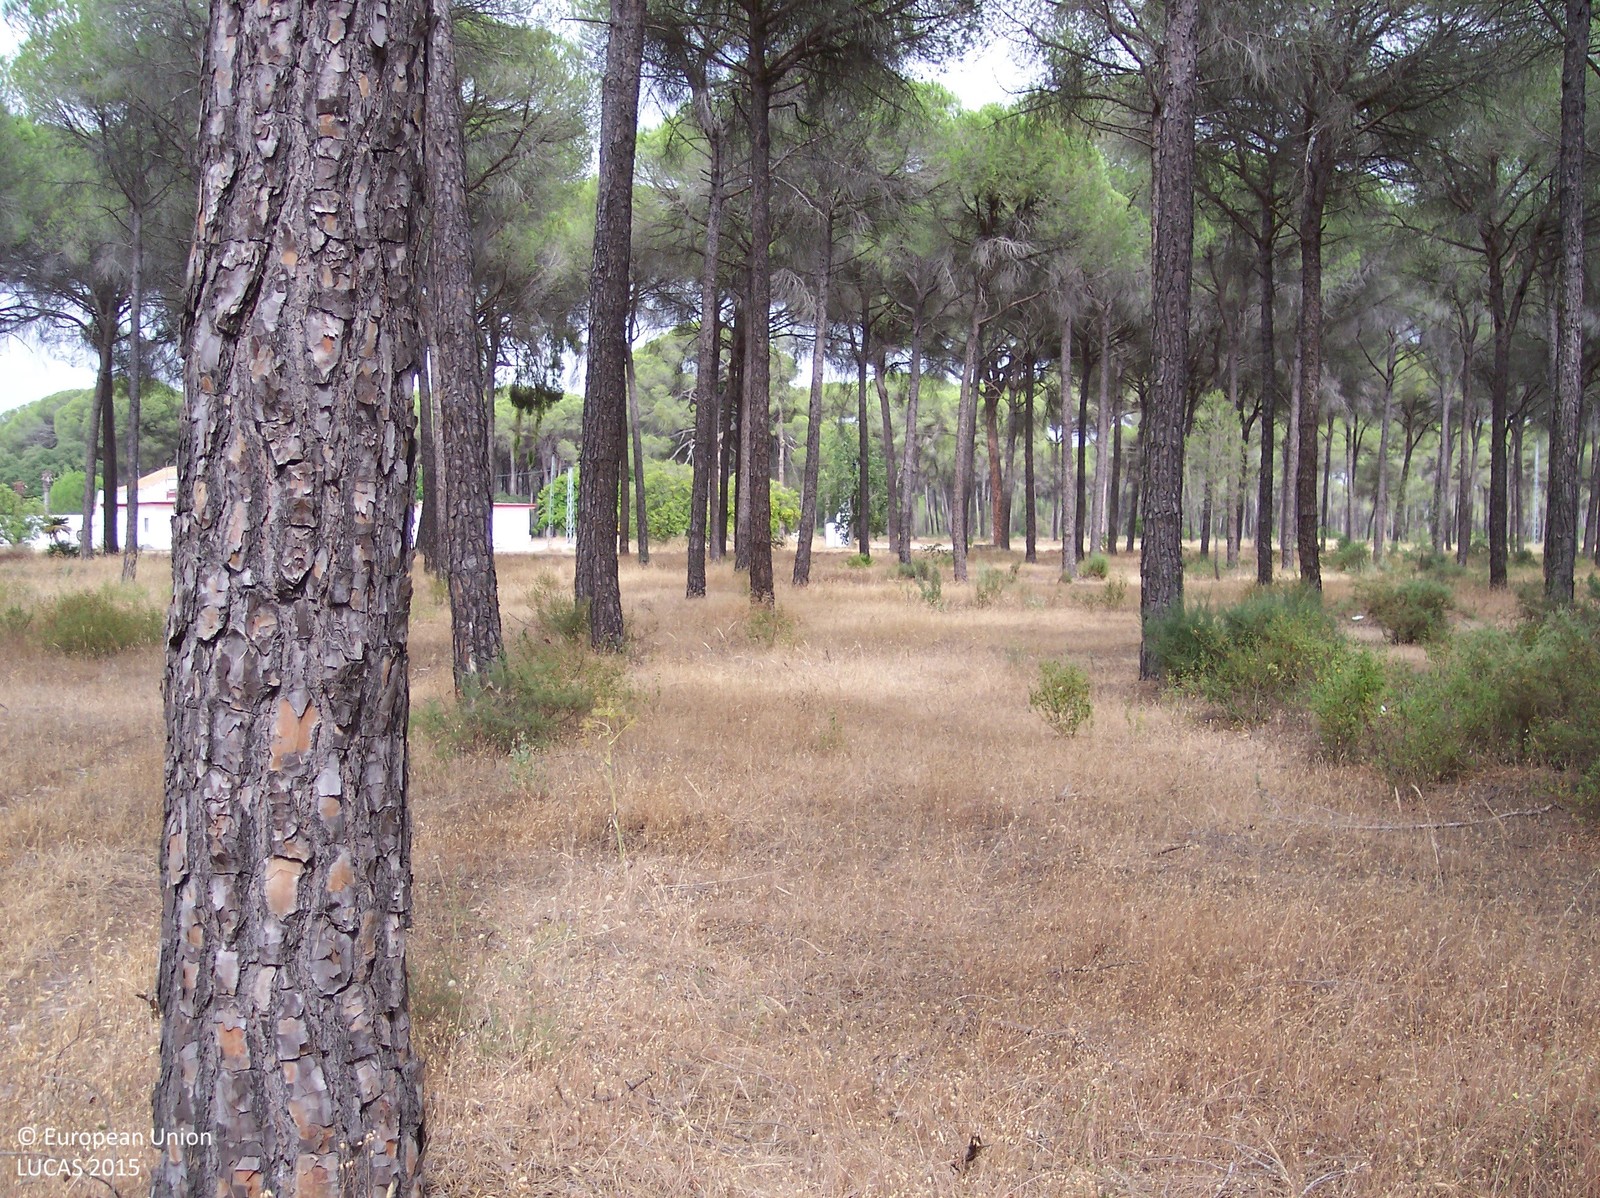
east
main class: Woodland
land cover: Pine dominated coniferous woodland
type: coniferous forest of the mediterranean region
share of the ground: > 75 %
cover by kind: coniferous forest trees 80 %, unconsolidated bare surface 10 %, shrubs 5 %, herbaceous plants 5 %
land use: Forestry
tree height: > 5 m
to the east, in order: Pine dominated coniferous woodland; Paved roads, cycling and walking lanes; Pine dominated coniferous woodland
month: June
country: ES
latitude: 37.2842
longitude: -6.4405
